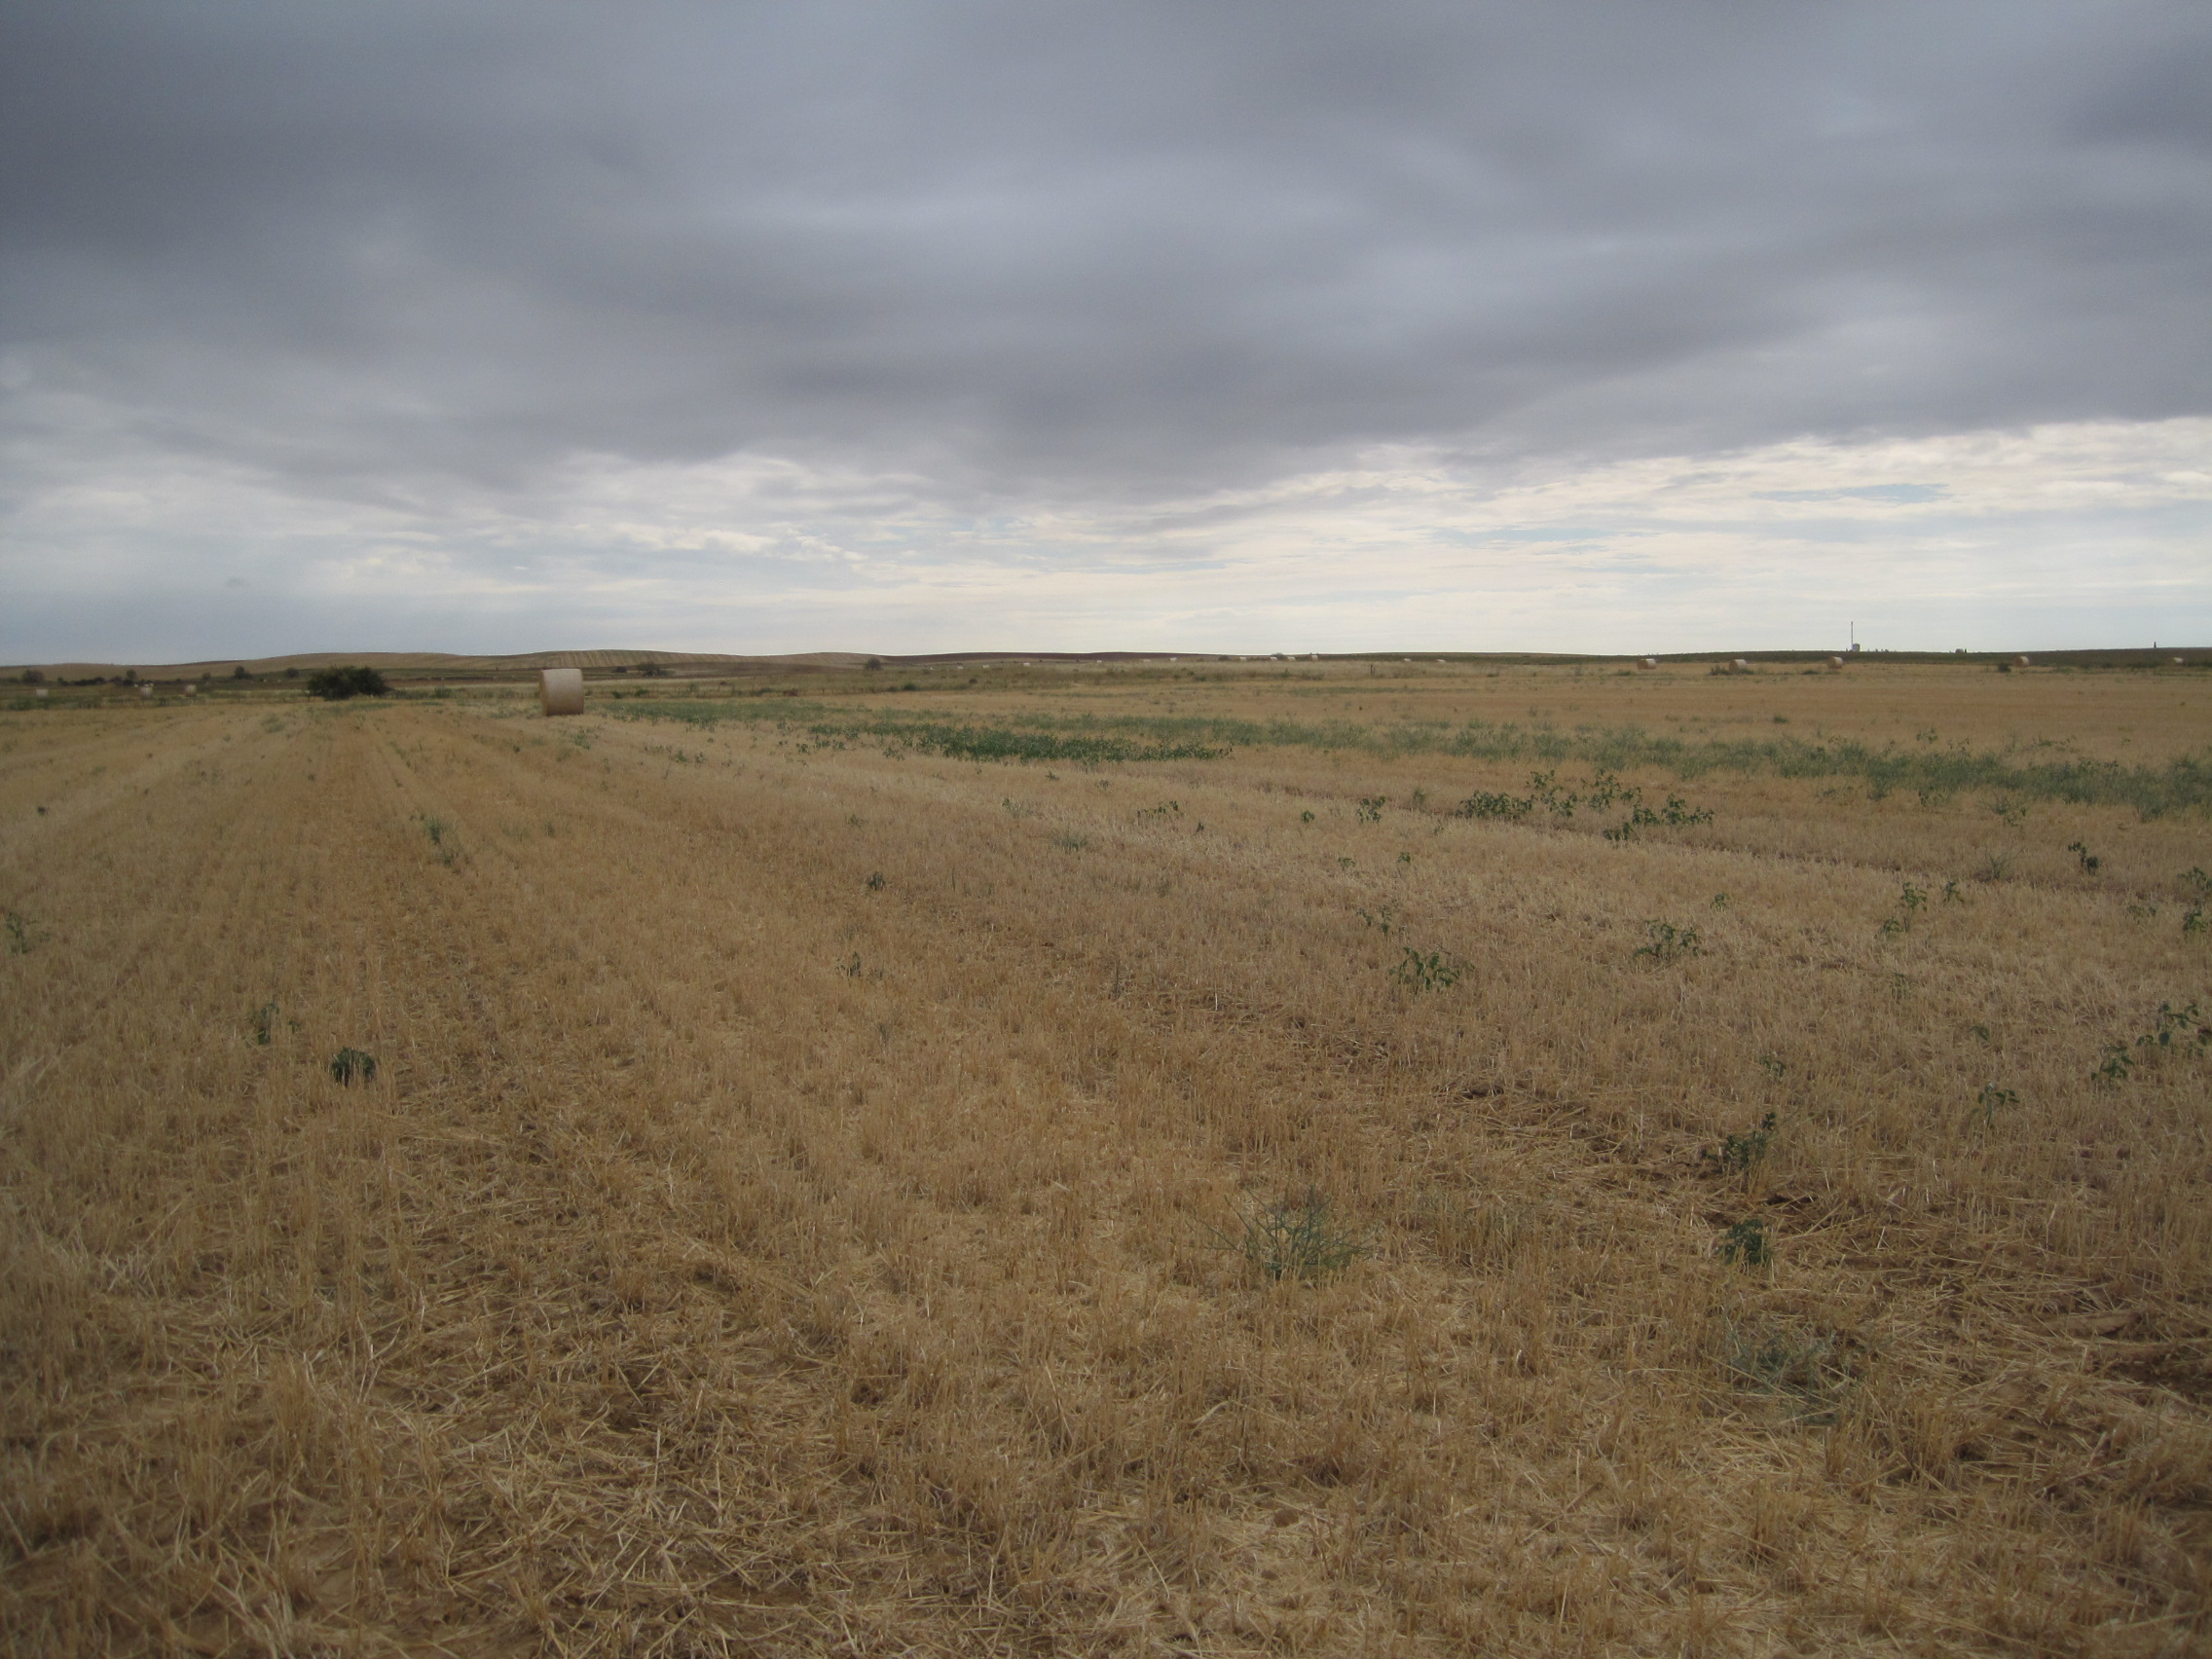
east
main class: Cropland
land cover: Barley
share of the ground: < 10 %
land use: Agriculture (excluding fallow land and kitchen gardens)
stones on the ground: < 10 %
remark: Harvested field
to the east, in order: Barley; Grass margins; Tracks; Grass margins; Spontaneously vegetated surfaces
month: July
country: ES
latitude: 41.9956
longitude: -5.4301
